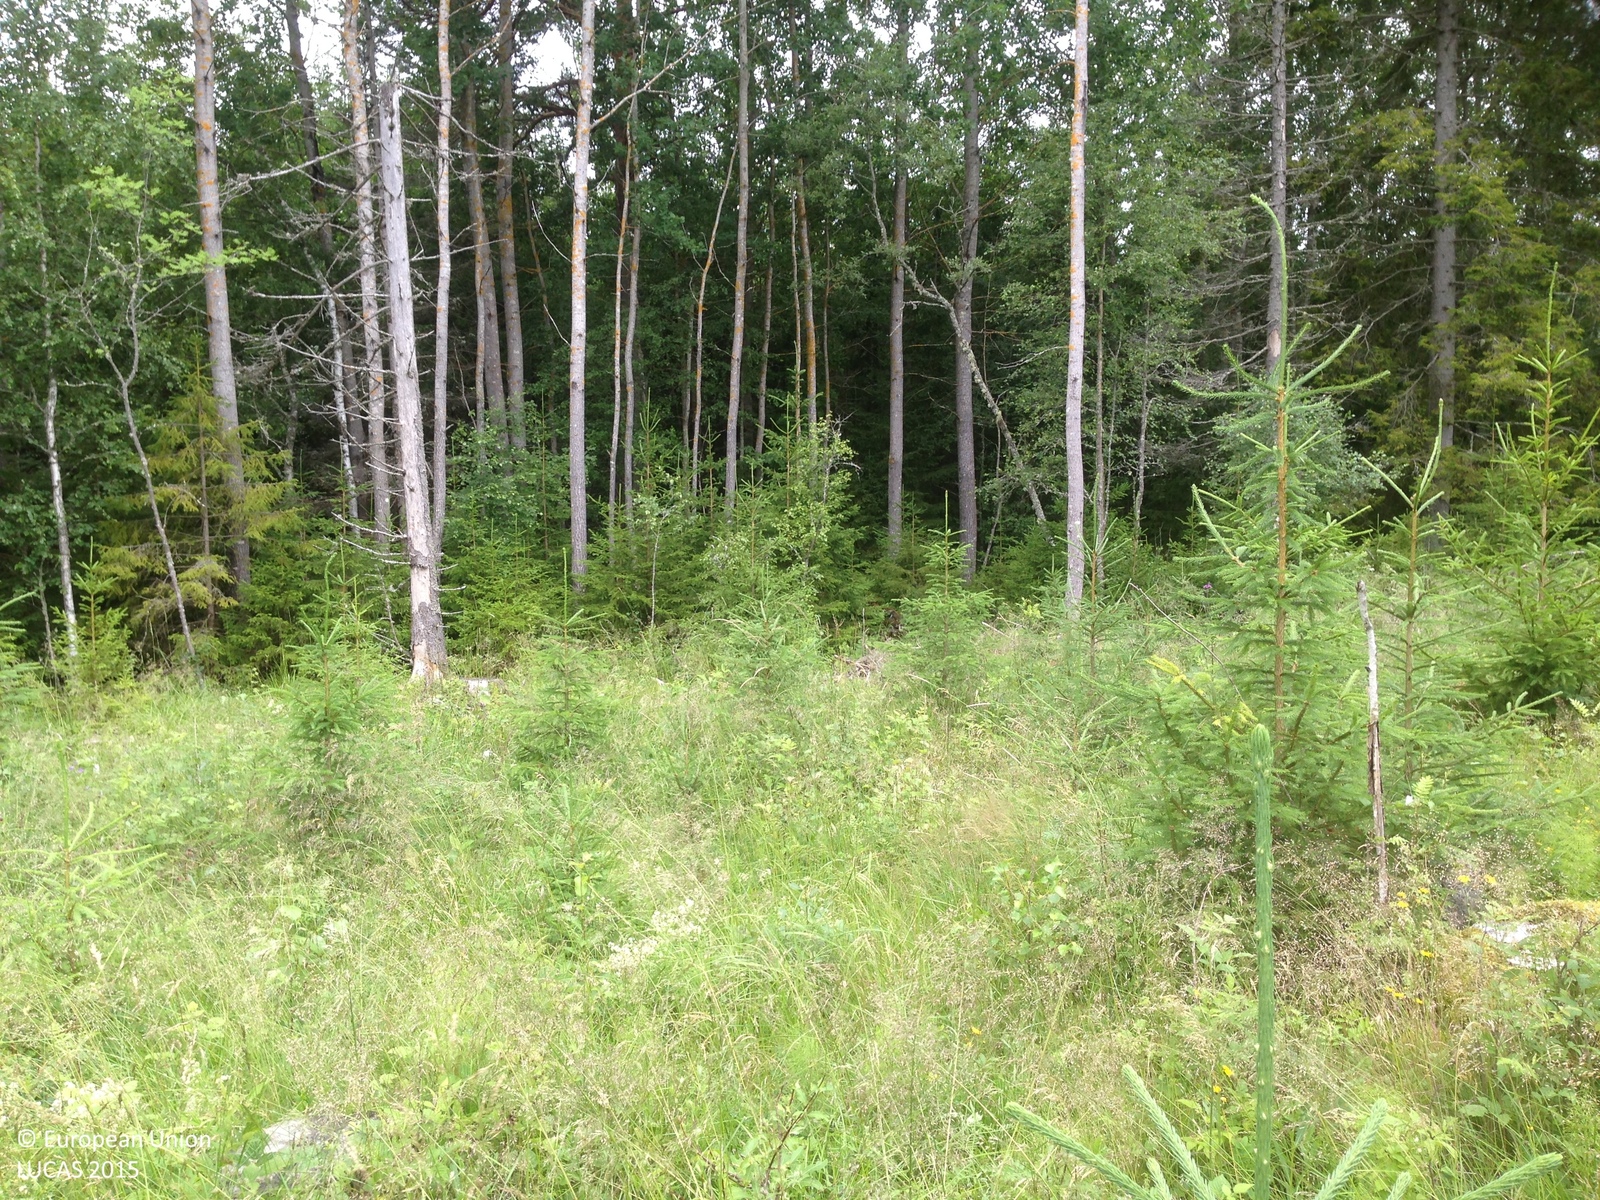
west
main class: Woodland
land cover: Spruce dominated coniferous woodland
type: boreal forest
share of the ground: 25 - 50 %
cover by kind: coniferous forest trees 40 %, herbaceous plants 25 %, lichens and mosses 25 %, broadleaved forest trees 10 %
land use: Forestry
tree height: < 5 m
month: July
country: SE
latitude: 59.8814
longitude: 16.9778
